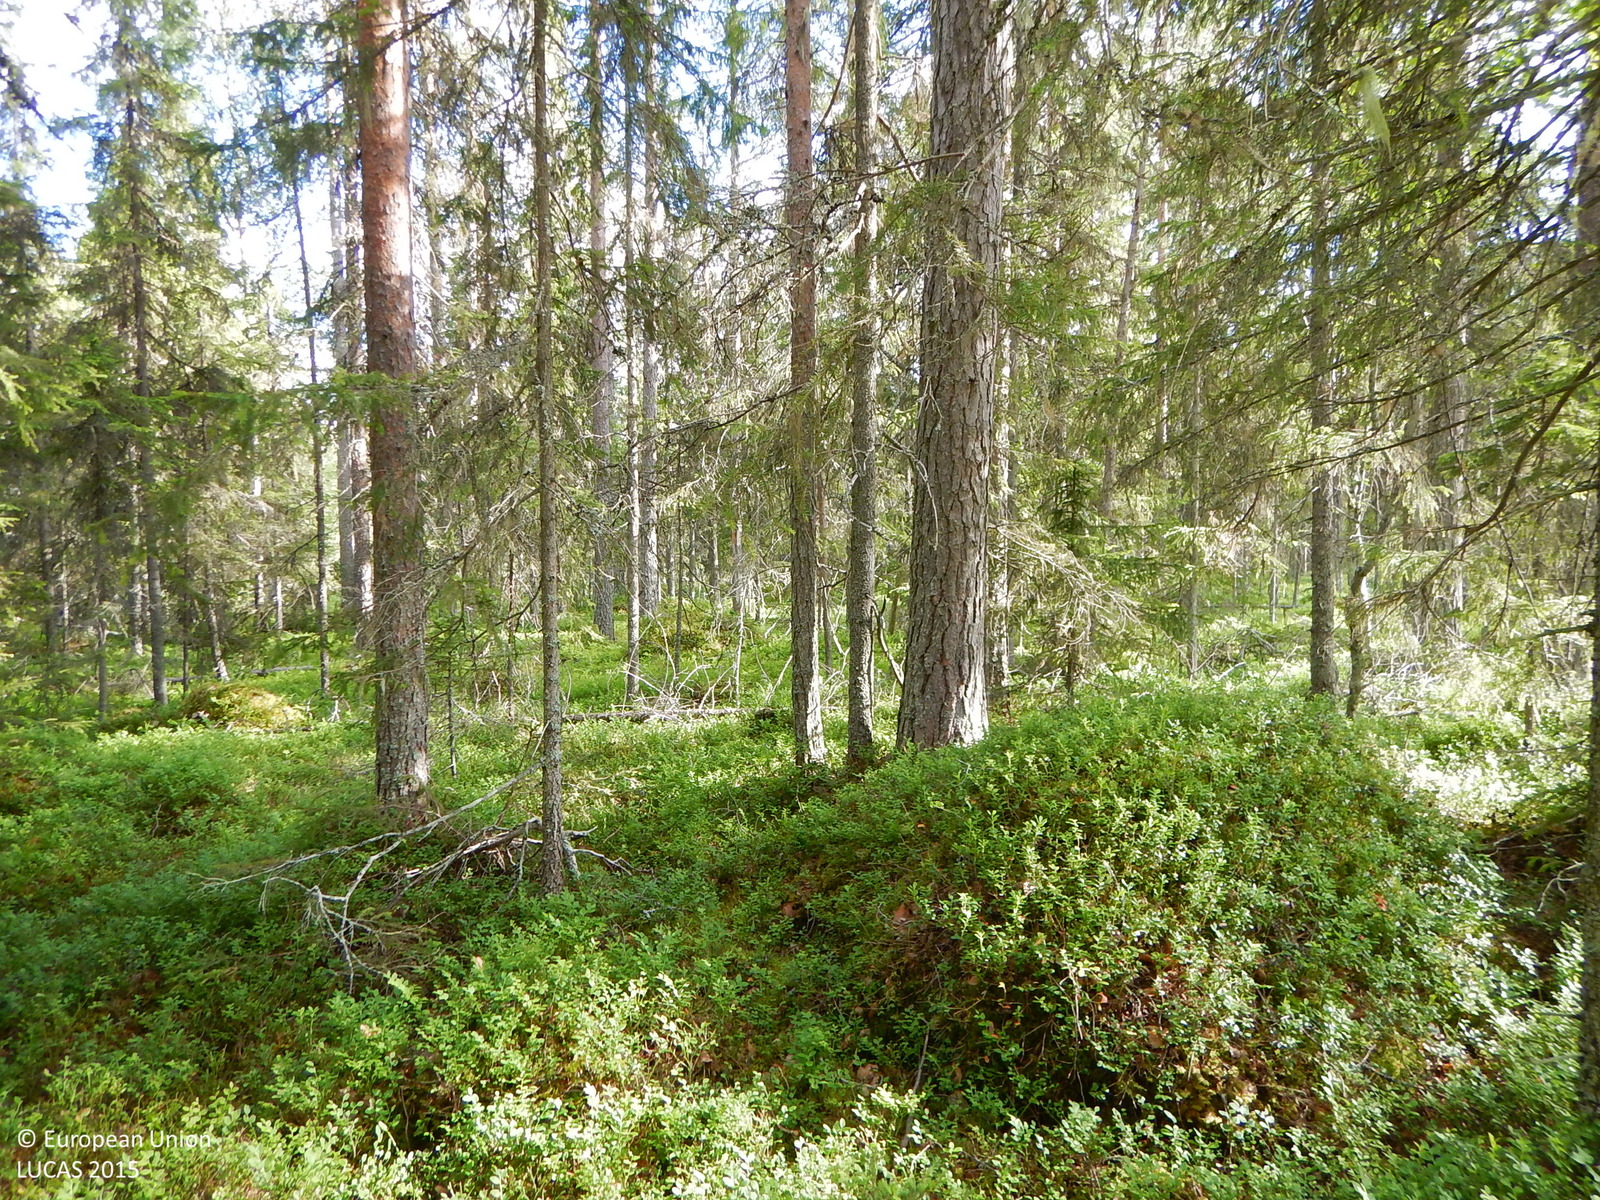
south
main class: Woodland
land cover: Spruce dominated coniferous woodland
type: boreal forest
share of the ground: 50 - 75 %
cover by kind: coniferous forest trees 65 %, shrubs 15 %, lichens and mosses 10 %, broadleaved forest trees 5 %, herbaceous plants 5 %
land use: Forestry
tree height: > 5 m
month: July
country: SE
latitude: 64.8249
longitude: 20.3601
